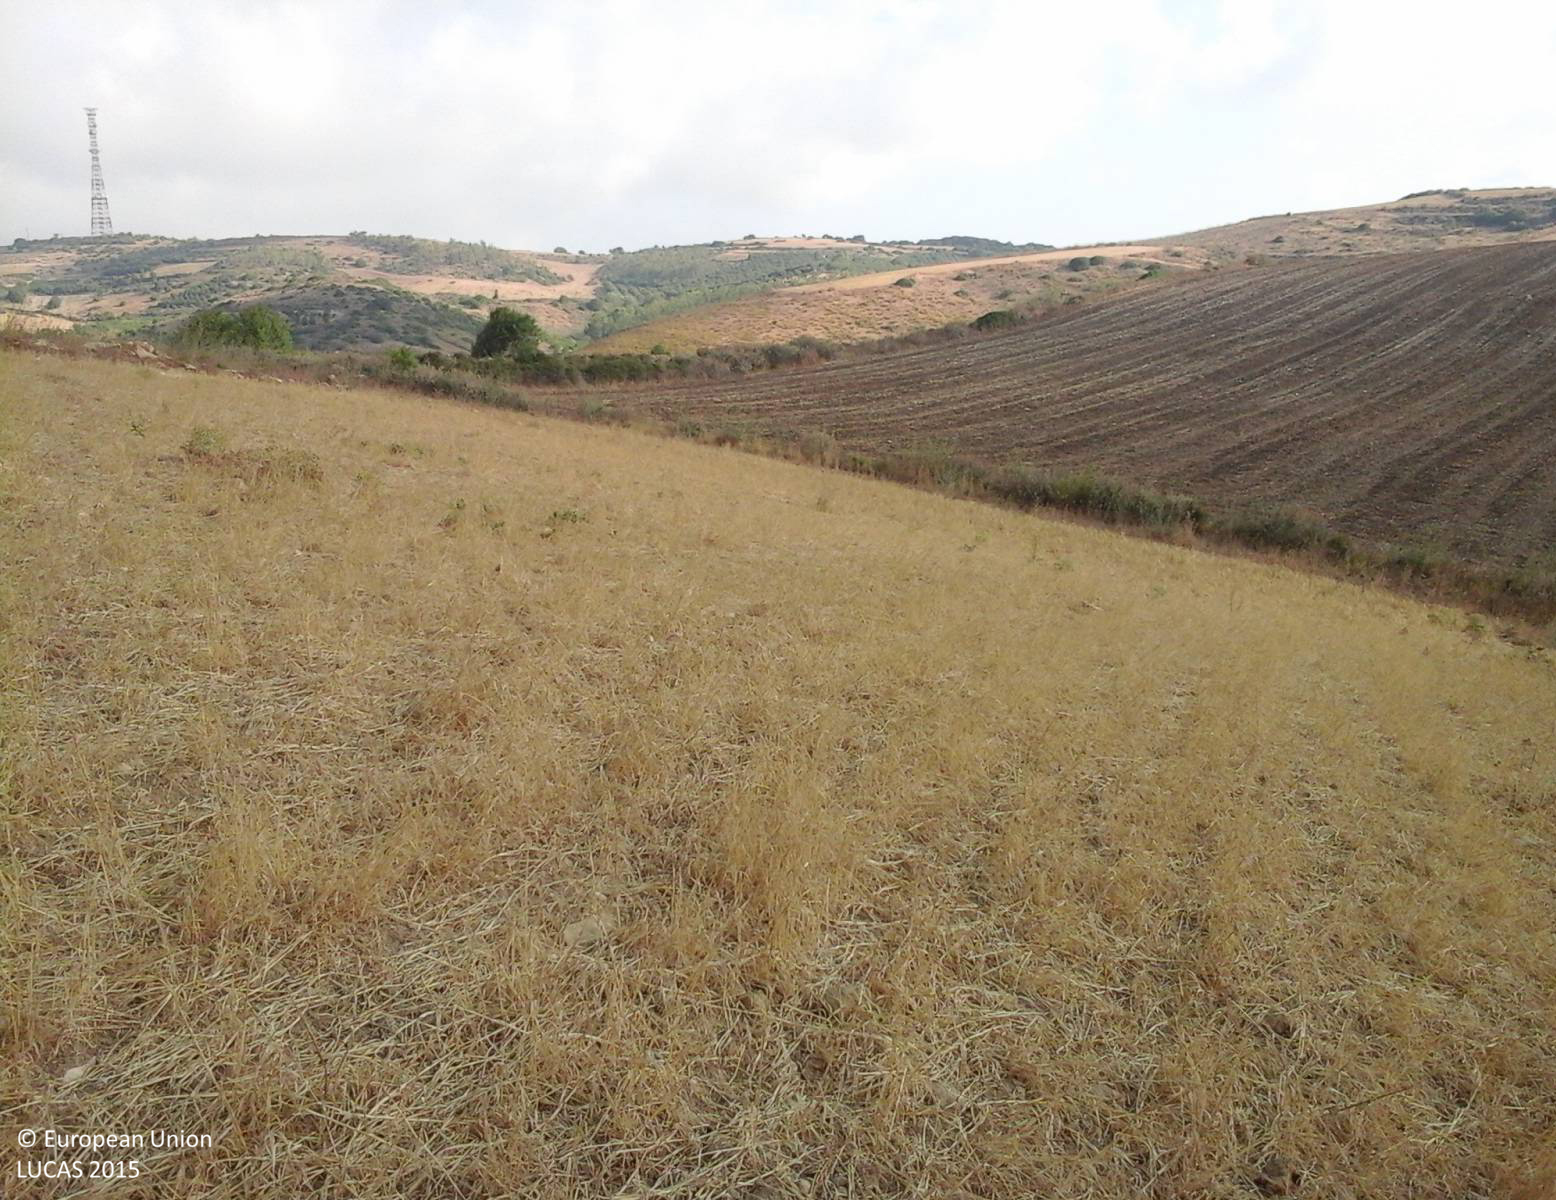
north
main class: Cropland
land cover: Mixed cereals for fodder
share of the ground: > 75 %
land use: Agriculture (excluding fallow land and kitchen gardens)
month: July
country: IT
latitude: 39.6089
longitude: 8.8768
